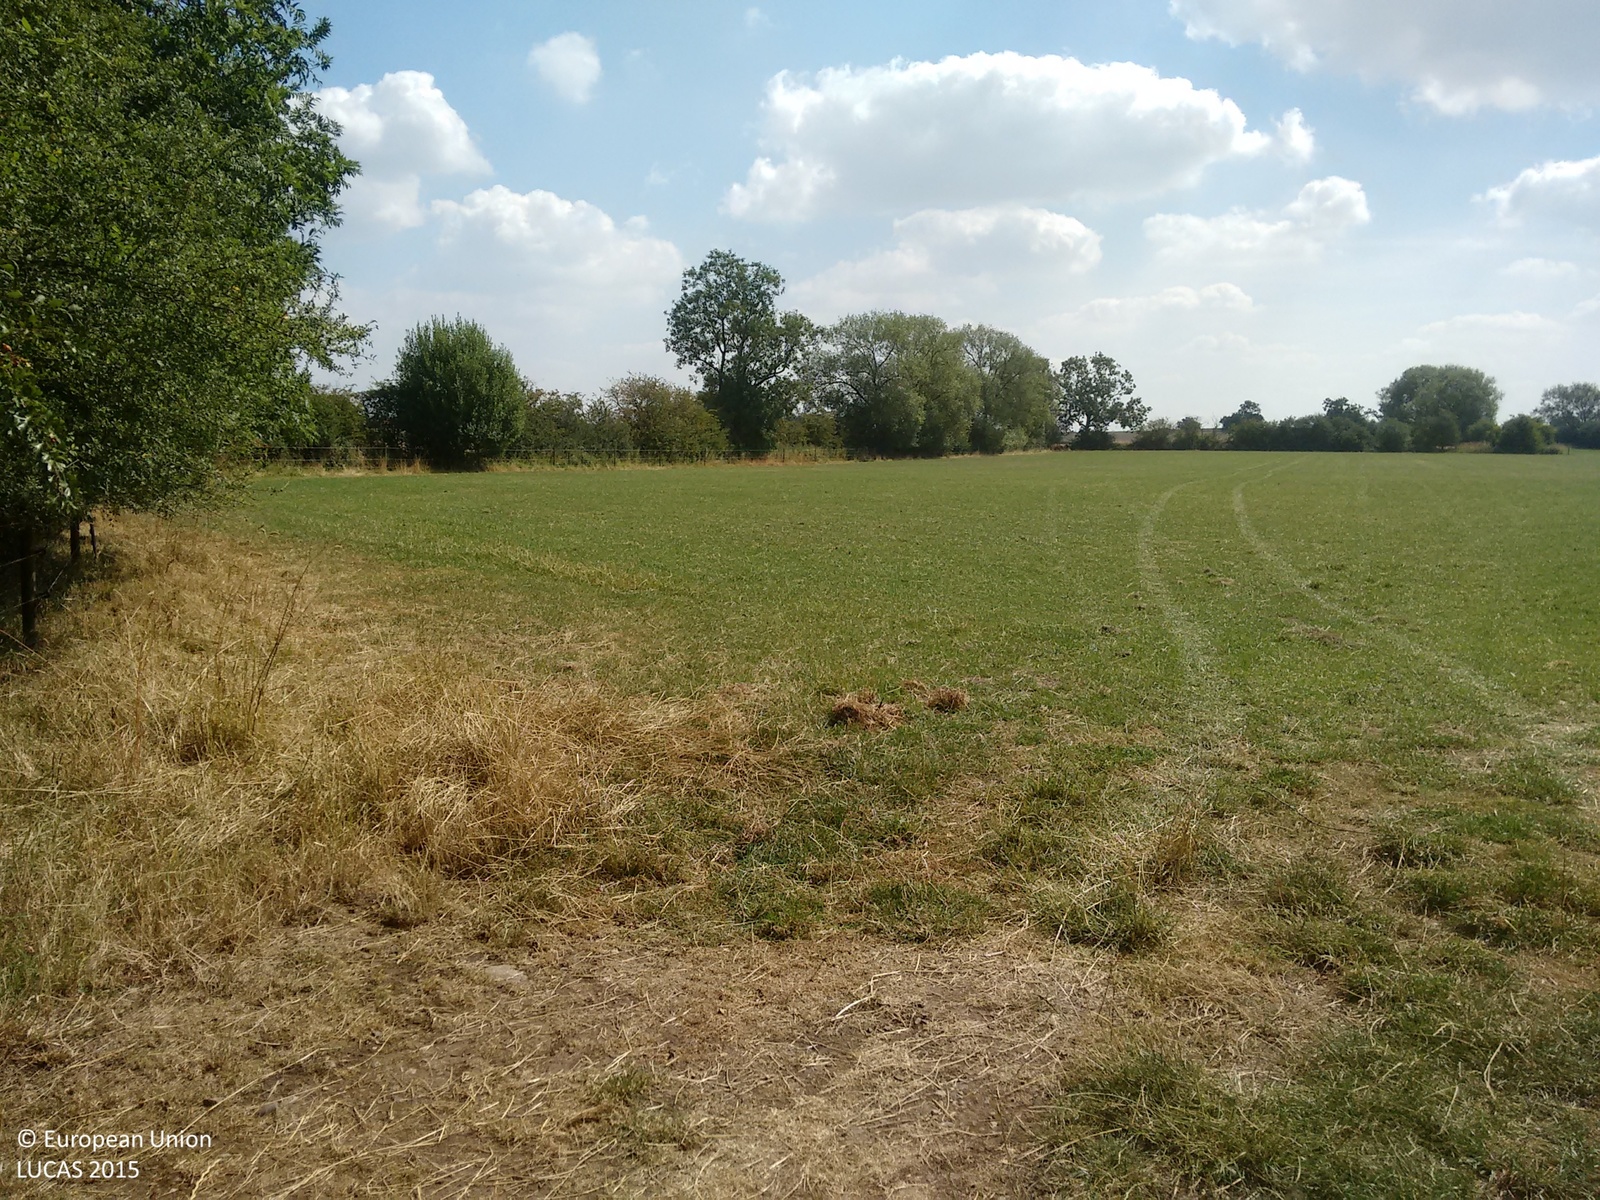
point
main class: Grassland
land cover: Grassland without tree/shrub cover
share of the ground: > 75 %
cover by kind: herbaceous plants 100 %
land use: Agriculture (excluding fallow land and kitchen gardens)
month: August
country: GB
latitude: 52.6160
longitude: -1.4974
